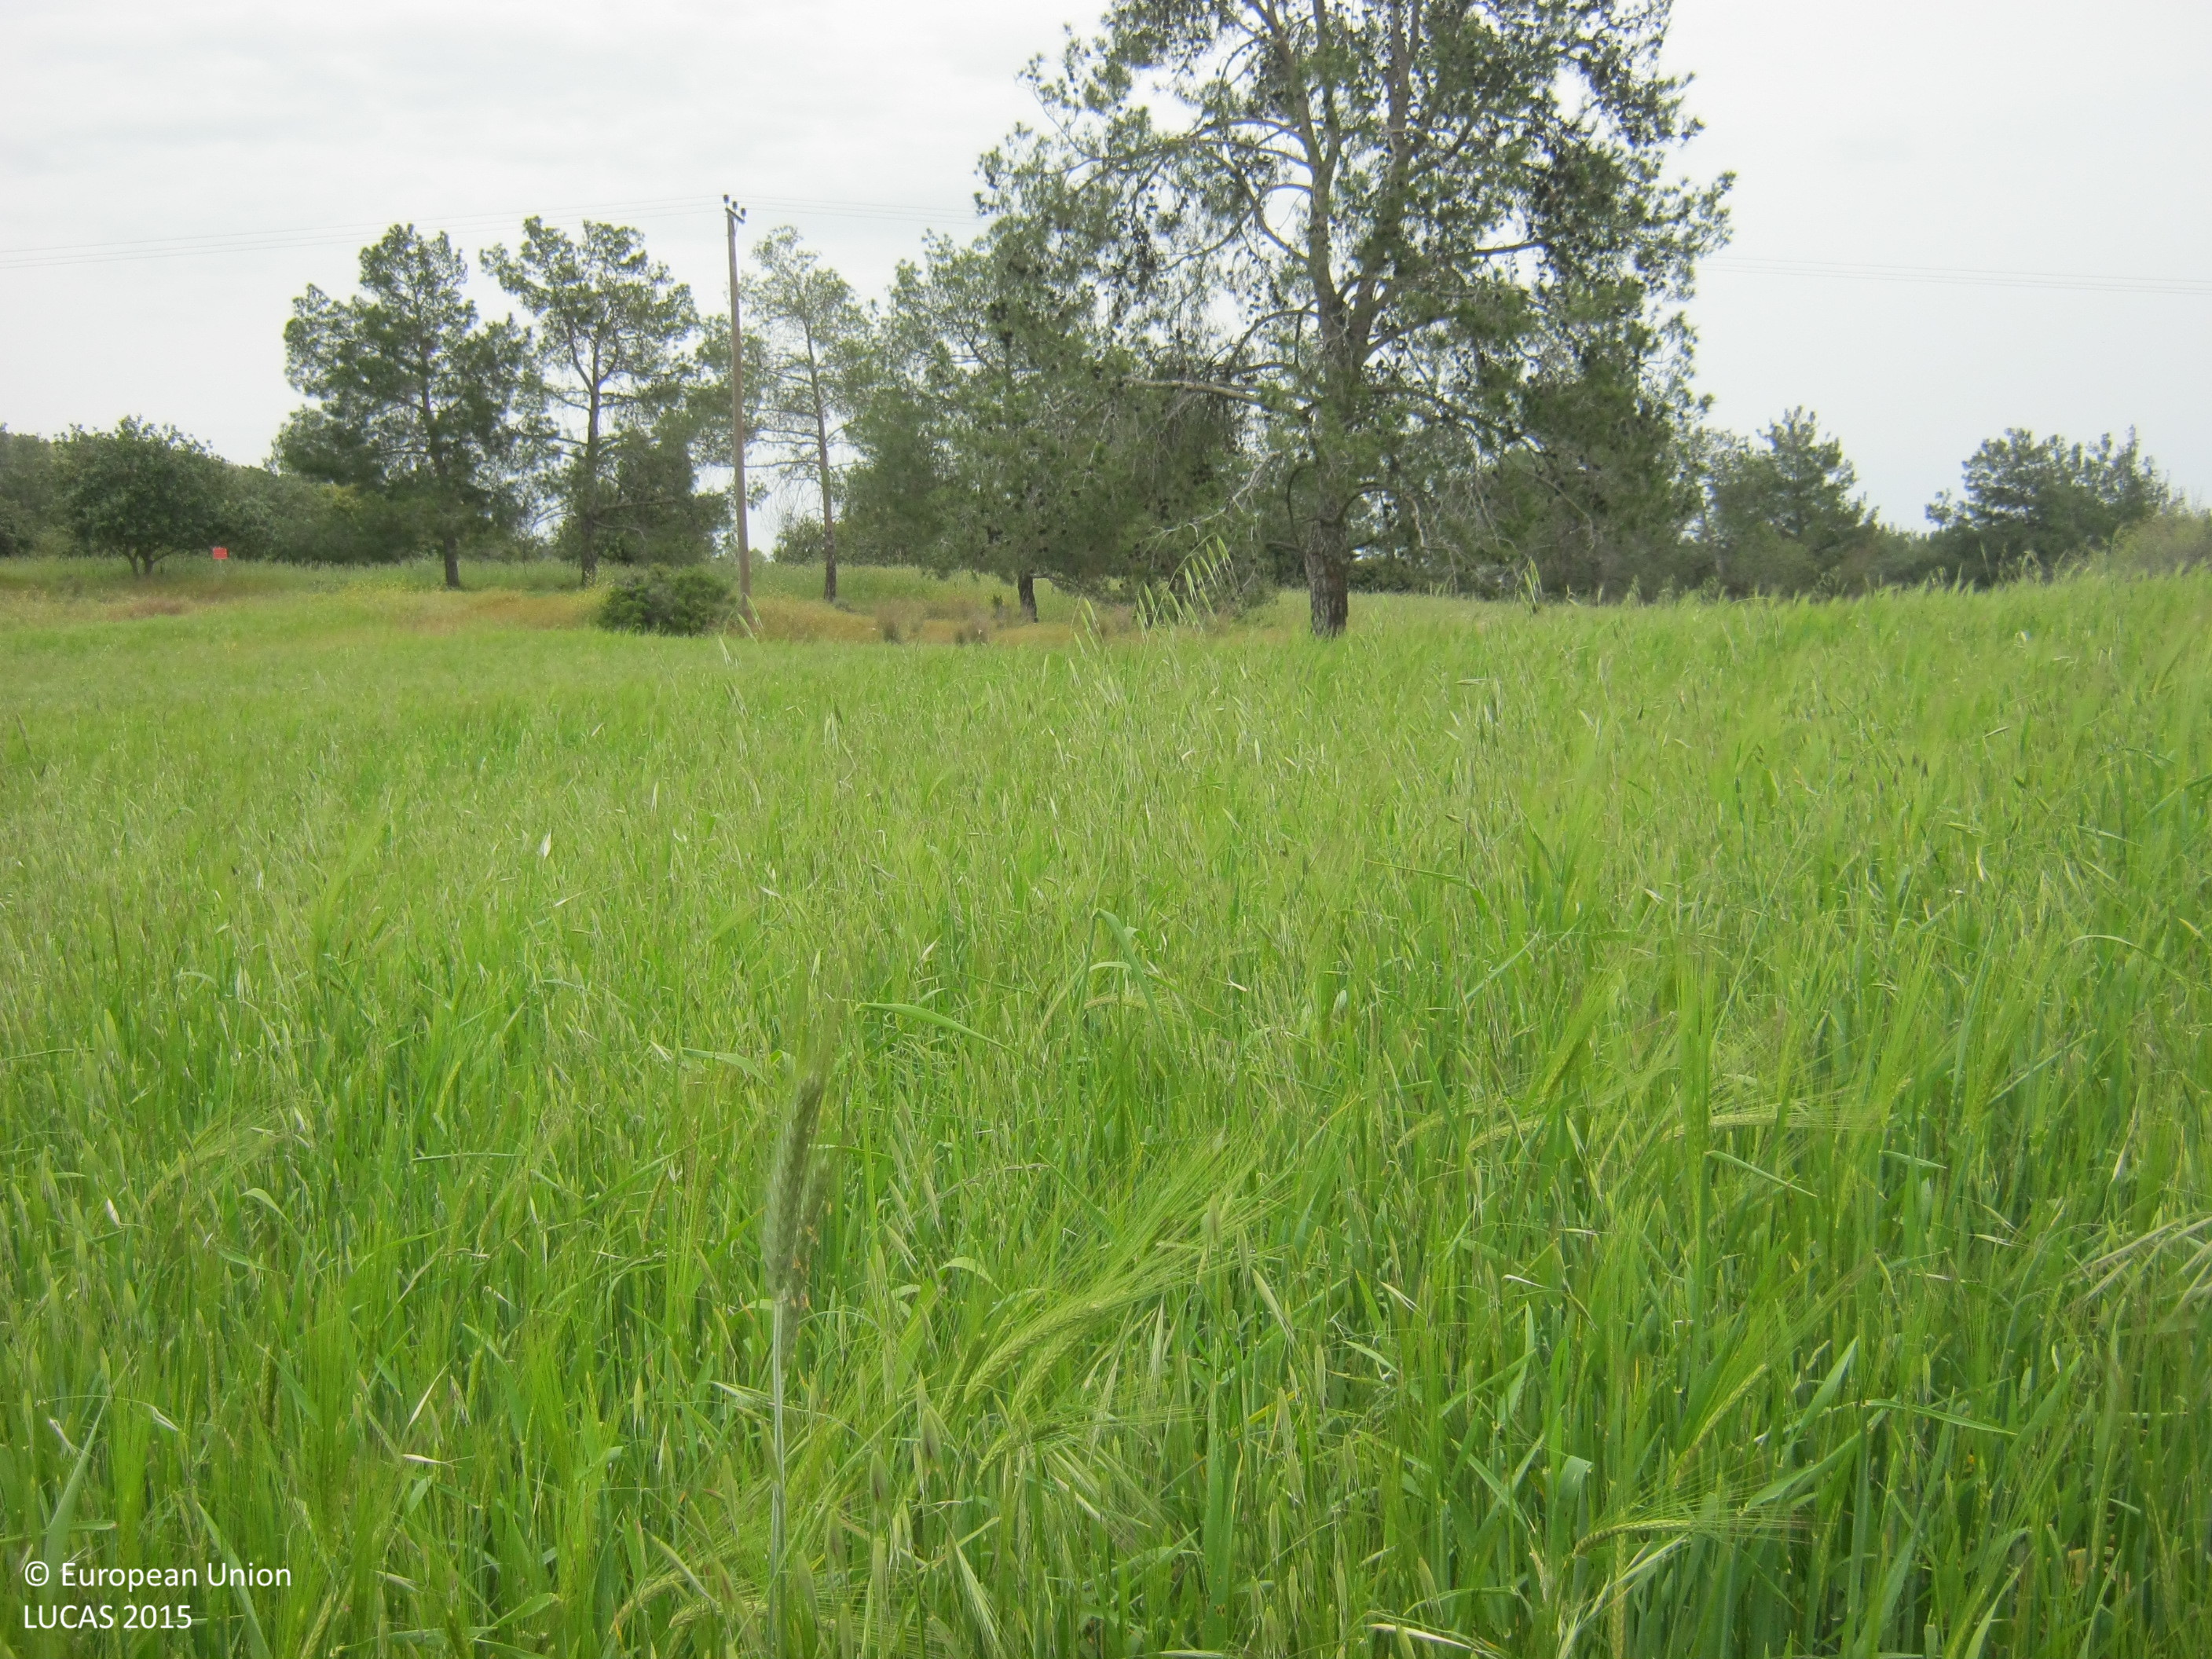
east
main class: Cropland
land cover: Common wheat
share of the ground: > 75 %
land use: Agriculture (excluding fallow land and kitchen gardens)
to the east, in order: Common wheat; Electric lines; Paved roads, cycling and walking lanes; Pine dominated coniferous woodland; Rivers and streams; Common wheat; Spontaneously vegetated surfaces; Olive groves; Common wheat
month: April
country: CY
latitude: 34.9263
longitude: 33.3604
